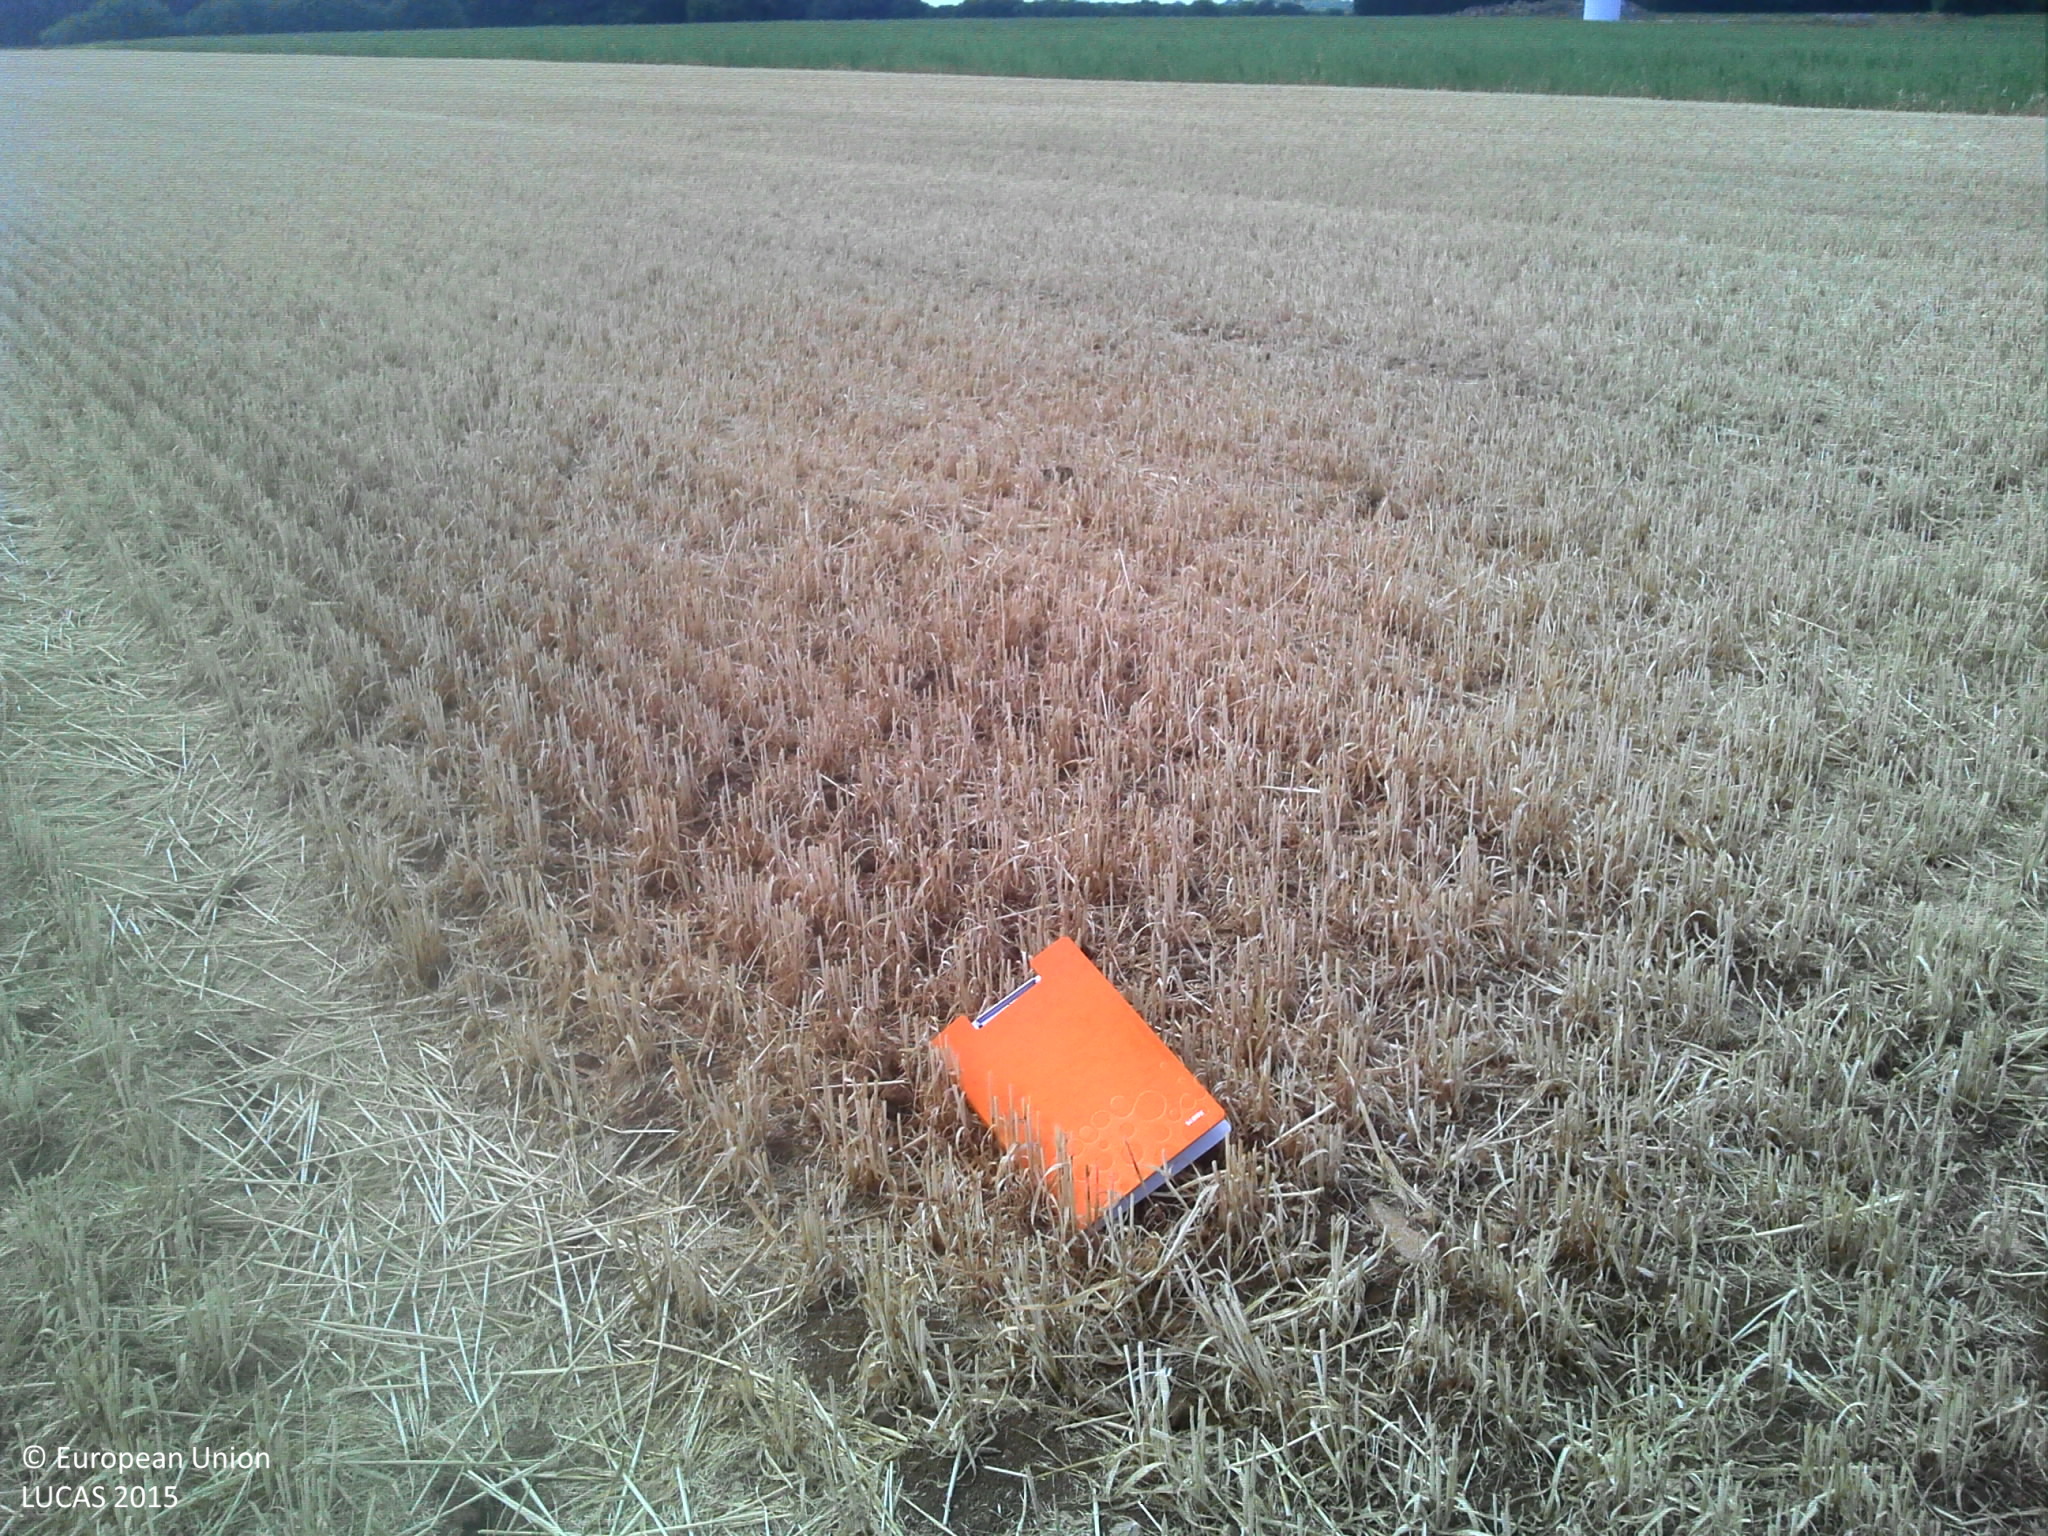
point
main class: Cropland
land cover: Barley
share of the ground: 10 - 25 %
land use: Agriculture (excluding fallow land and kitchen gardens)
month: July
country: FR
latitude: 47.7242
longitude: 5.2406
